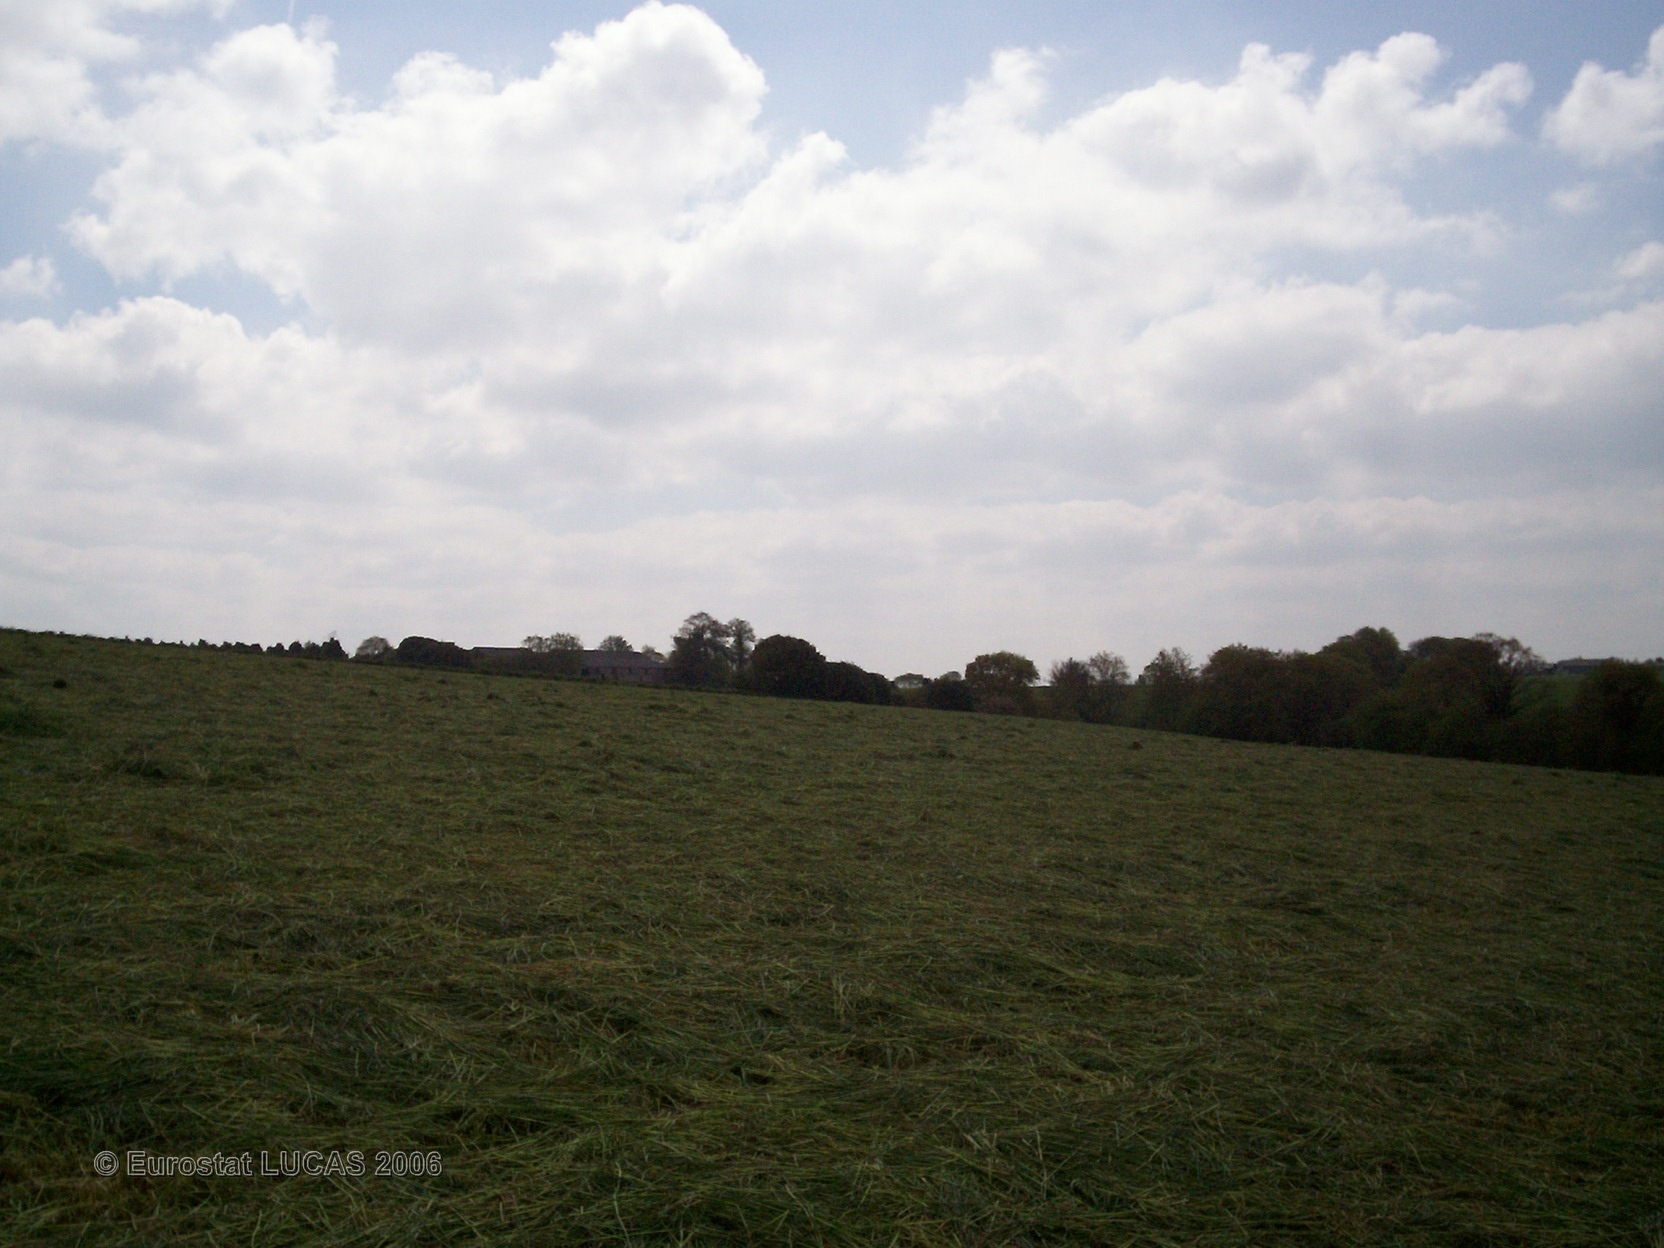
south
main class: Grassland
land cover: Grassland without tree/shrub cover
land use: Agriculture (excluding fallow land and kitchen gardens)
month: May
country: FR
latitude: 48.3347
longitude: -3.6657
